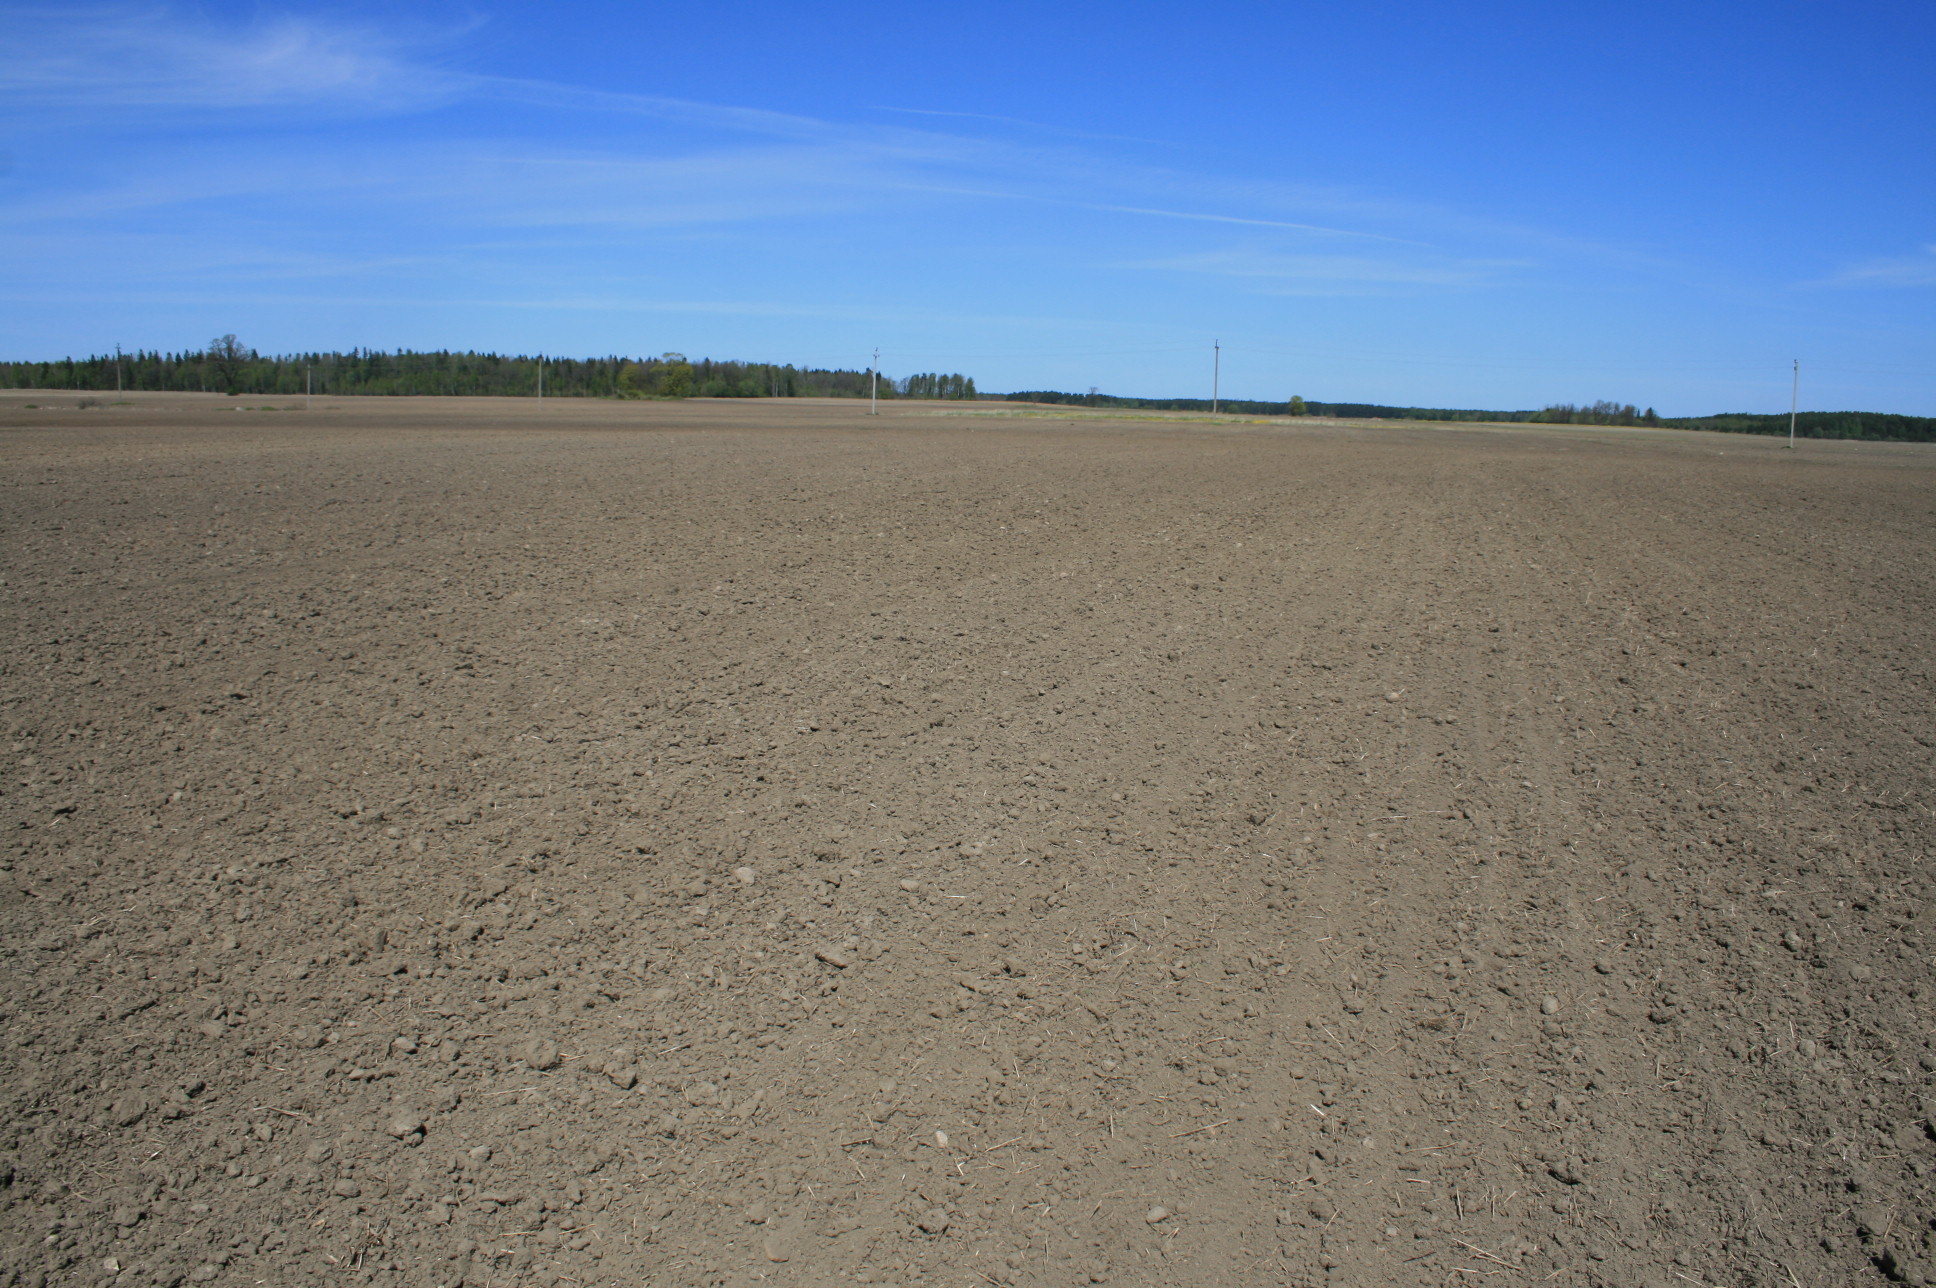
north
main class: Cropland
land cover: Barley
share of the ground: < 10 %
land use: Agriculture (excluding fallow land and kitchen gardens)
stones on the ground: < 10 %
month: May
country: LT
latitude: 56.0804
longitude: 21.3701
